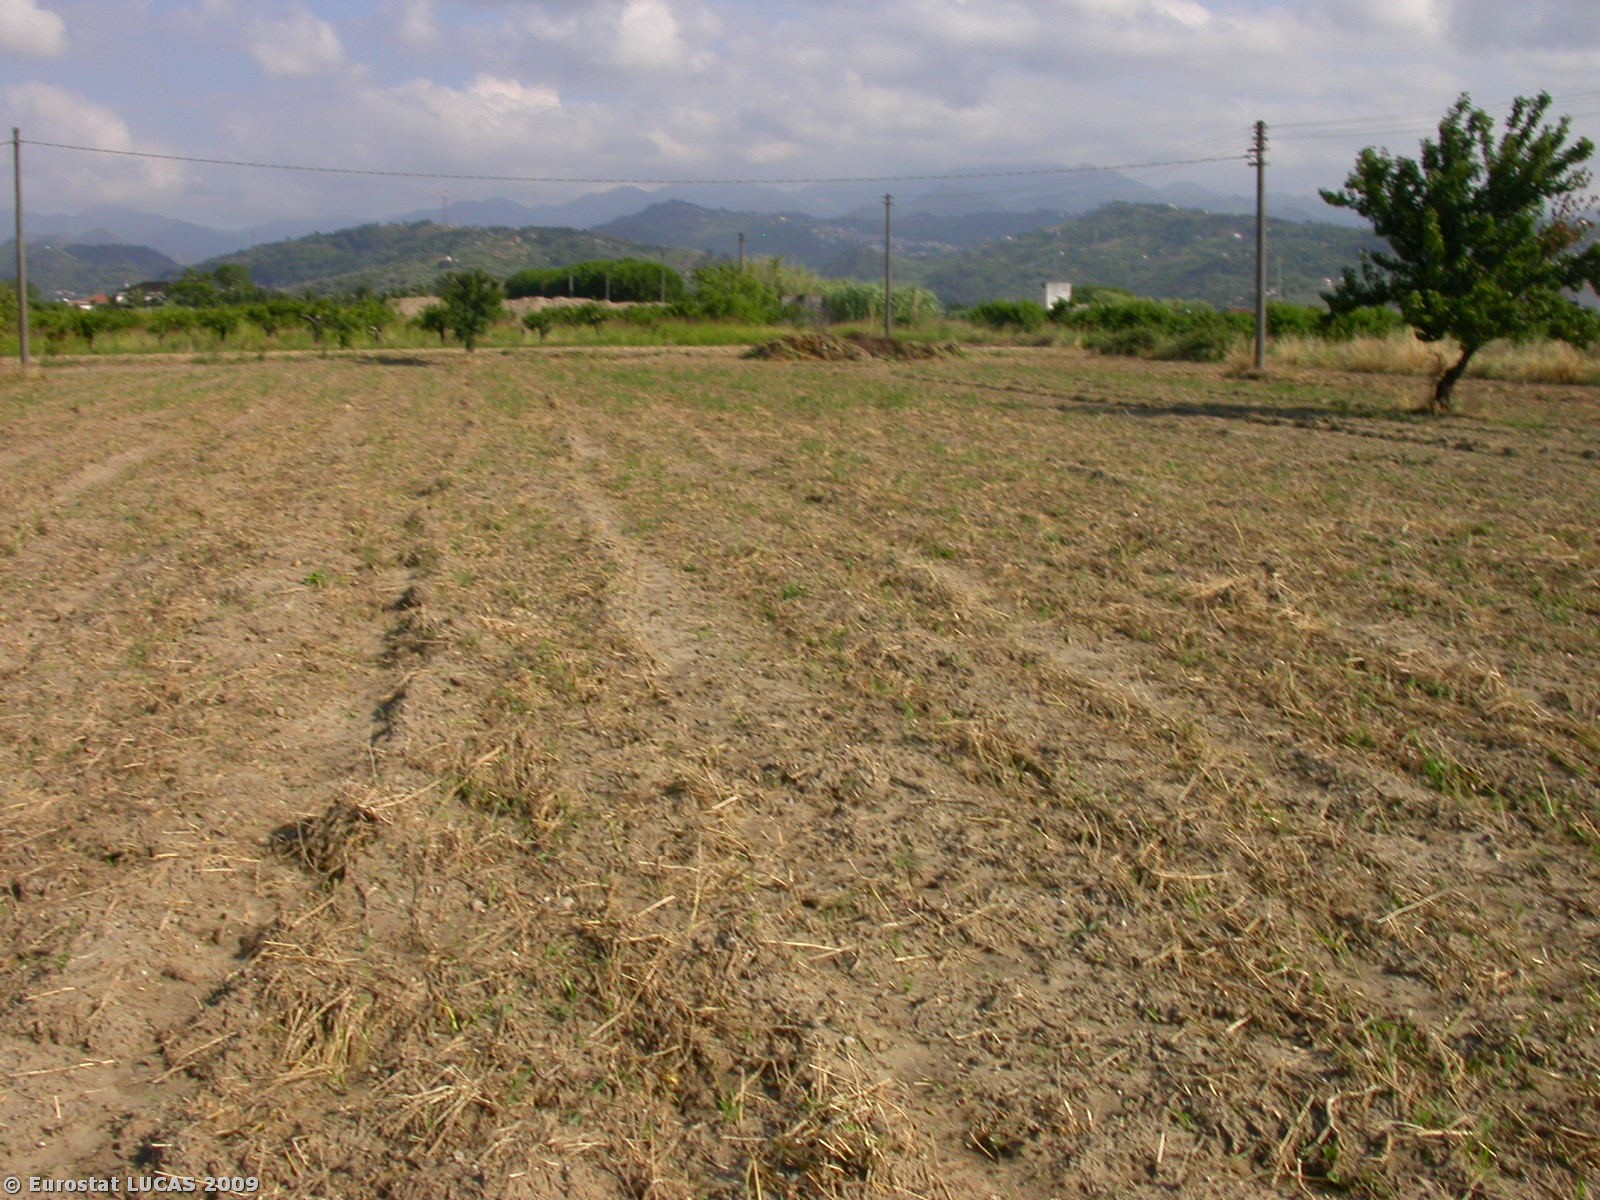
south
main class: Cropland
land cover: Potatoes
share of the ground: < 10 %
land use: Agriculture (excluding fallow land and kitchen gardens)
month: June
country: IT
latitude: 38.1972
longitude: 15.3443
